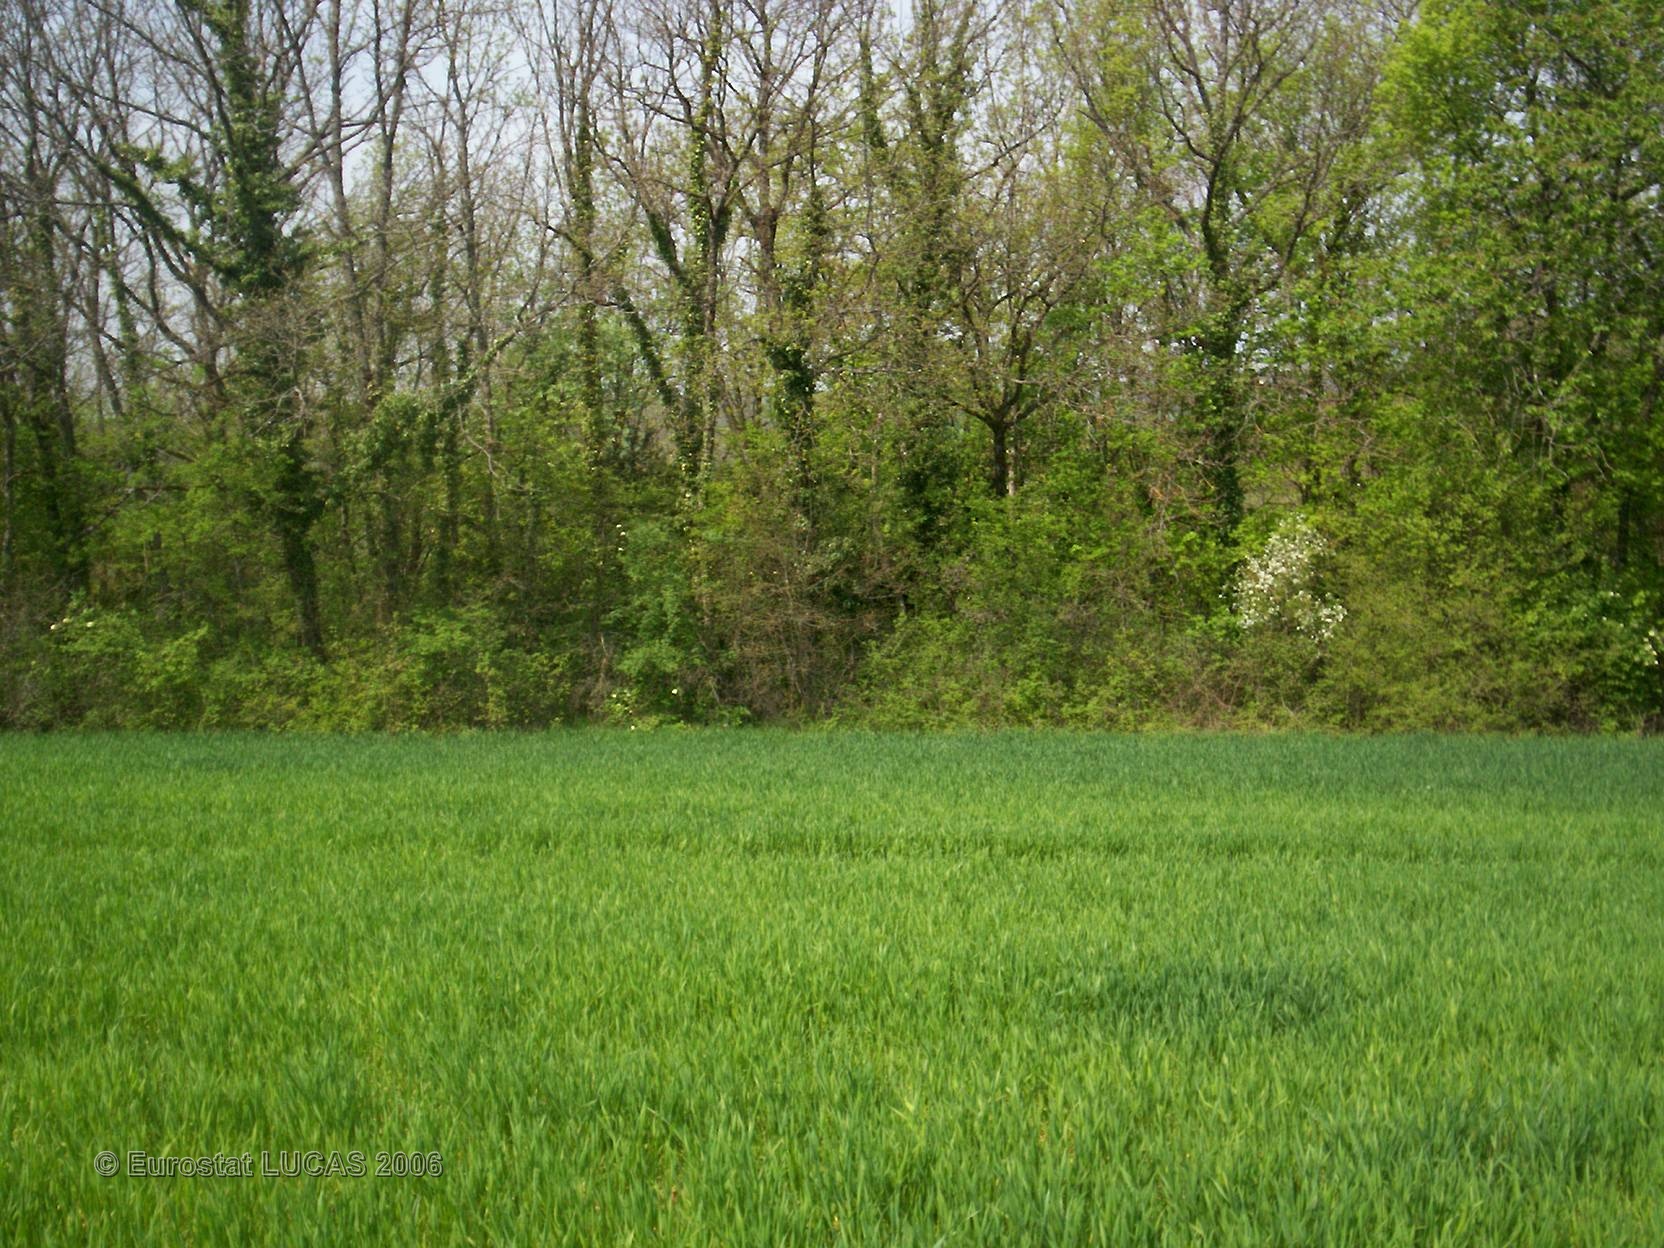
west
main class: Cropland
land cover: Common wheat
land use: Agriculture (excluding fallow land and kitchen gardens)
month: May
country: FR
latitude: 47.4805
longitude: 4.6515
